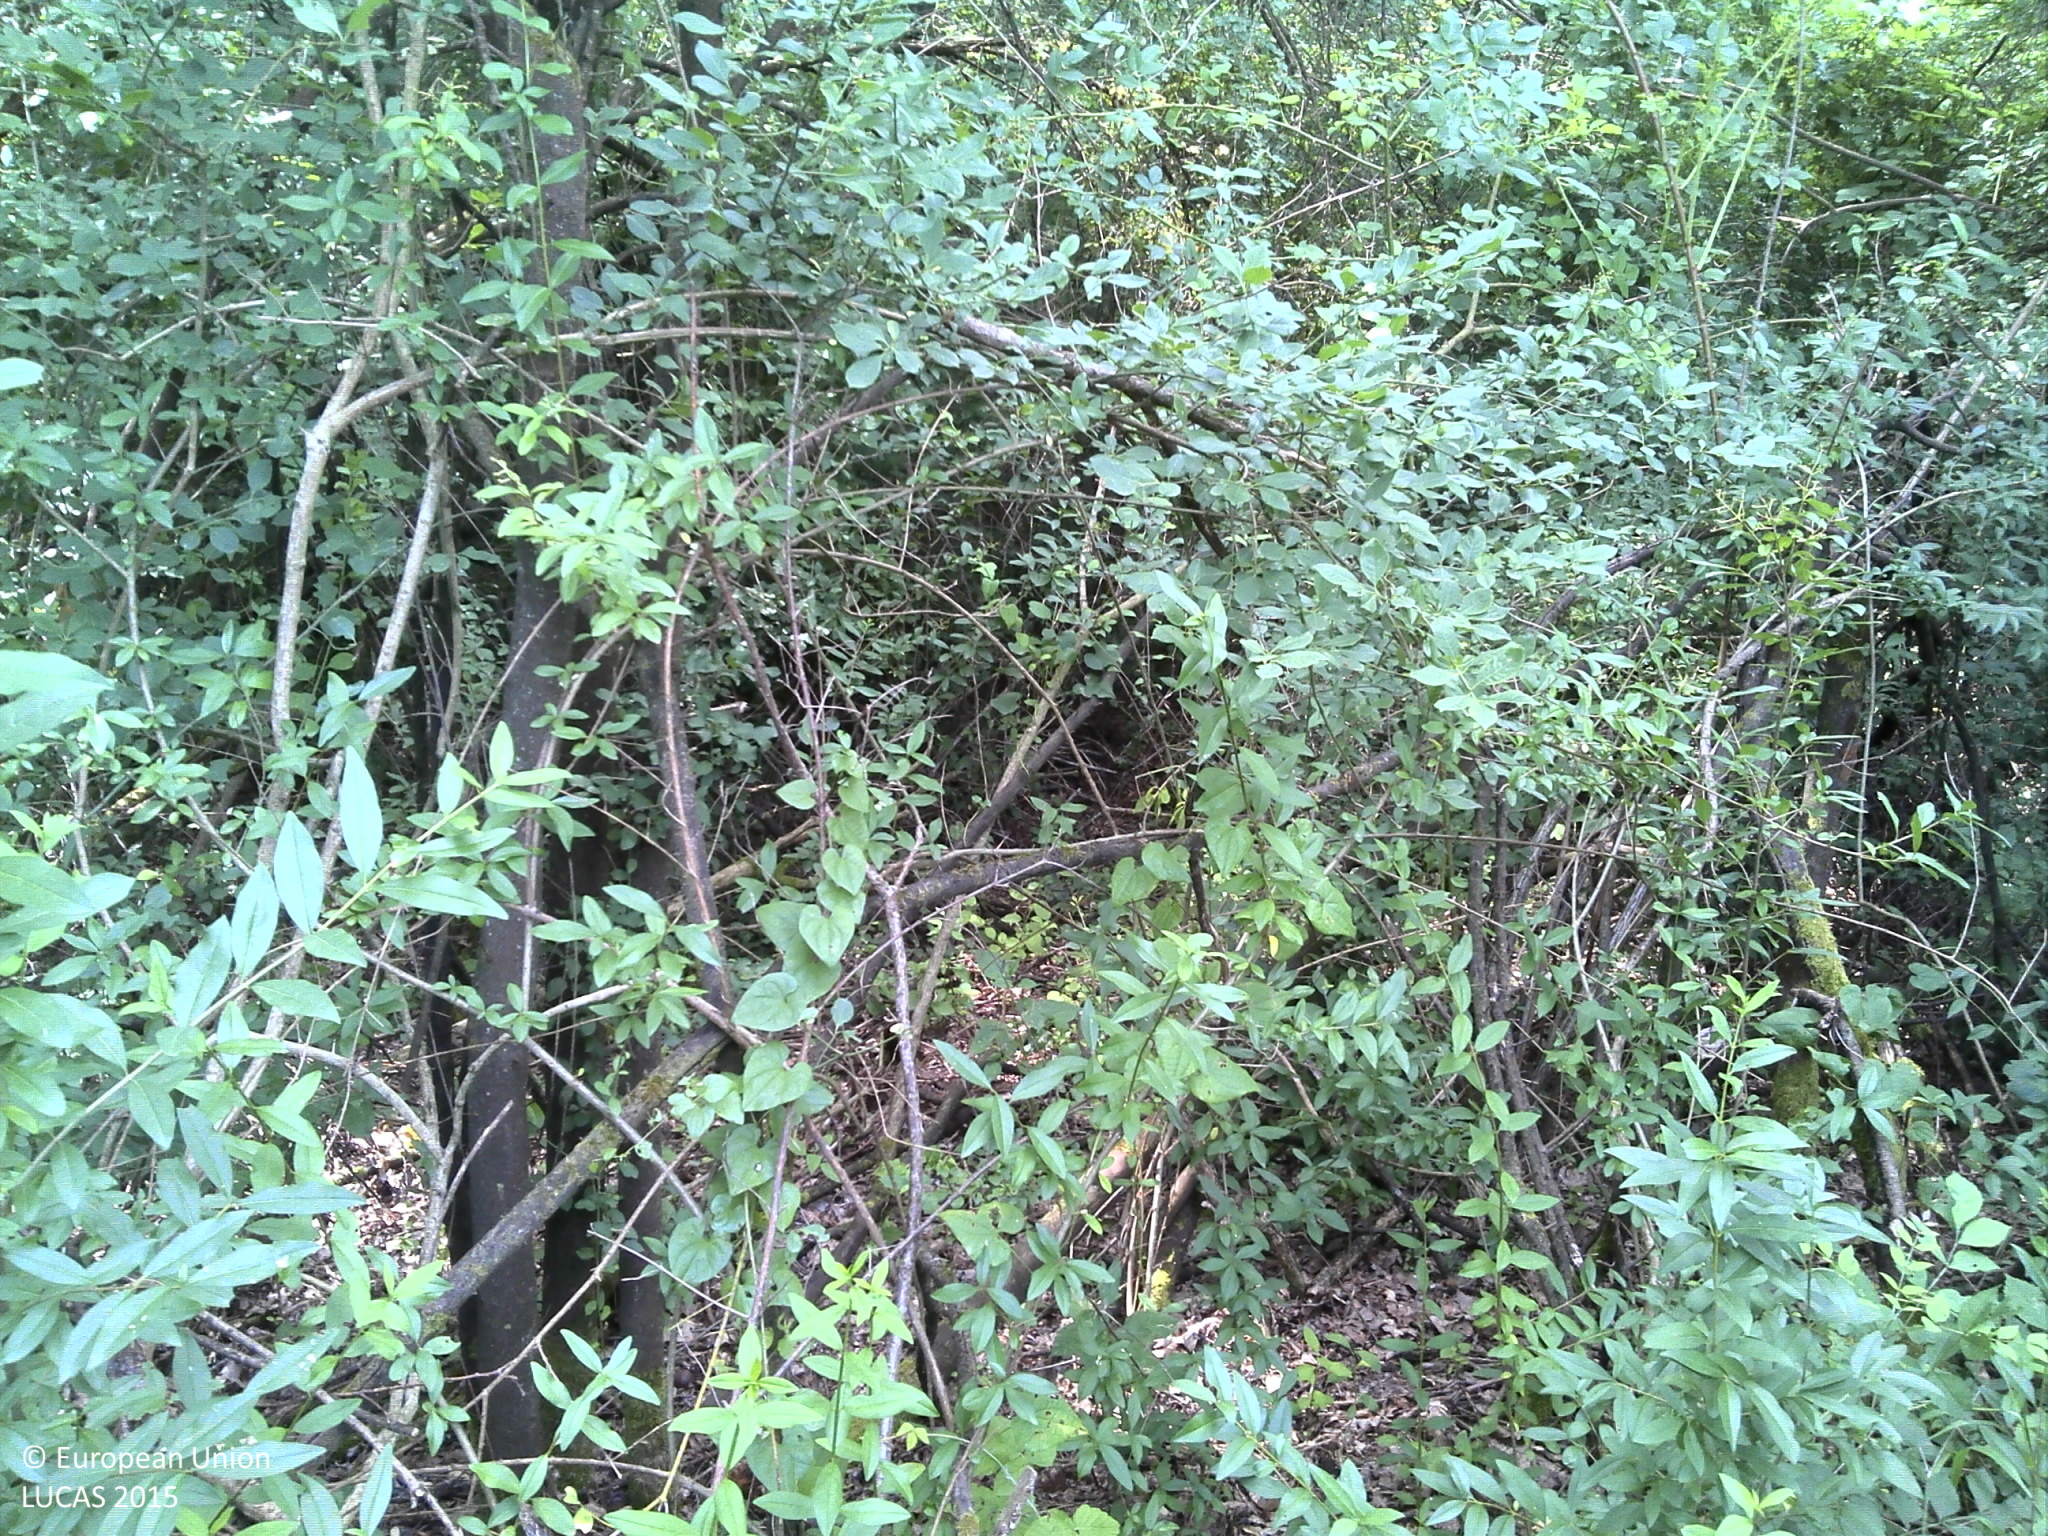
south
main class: Woodland
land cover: Broadleaved woodland
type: acidophilous oak and oak-birch forest
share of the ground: 50 - 75 %
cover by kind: broadleaved forest trees 75 %, shrubs 25 %
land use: Forestry
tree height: > 5 m
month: June
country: HR
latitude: 45.1019
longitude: 17.8680
